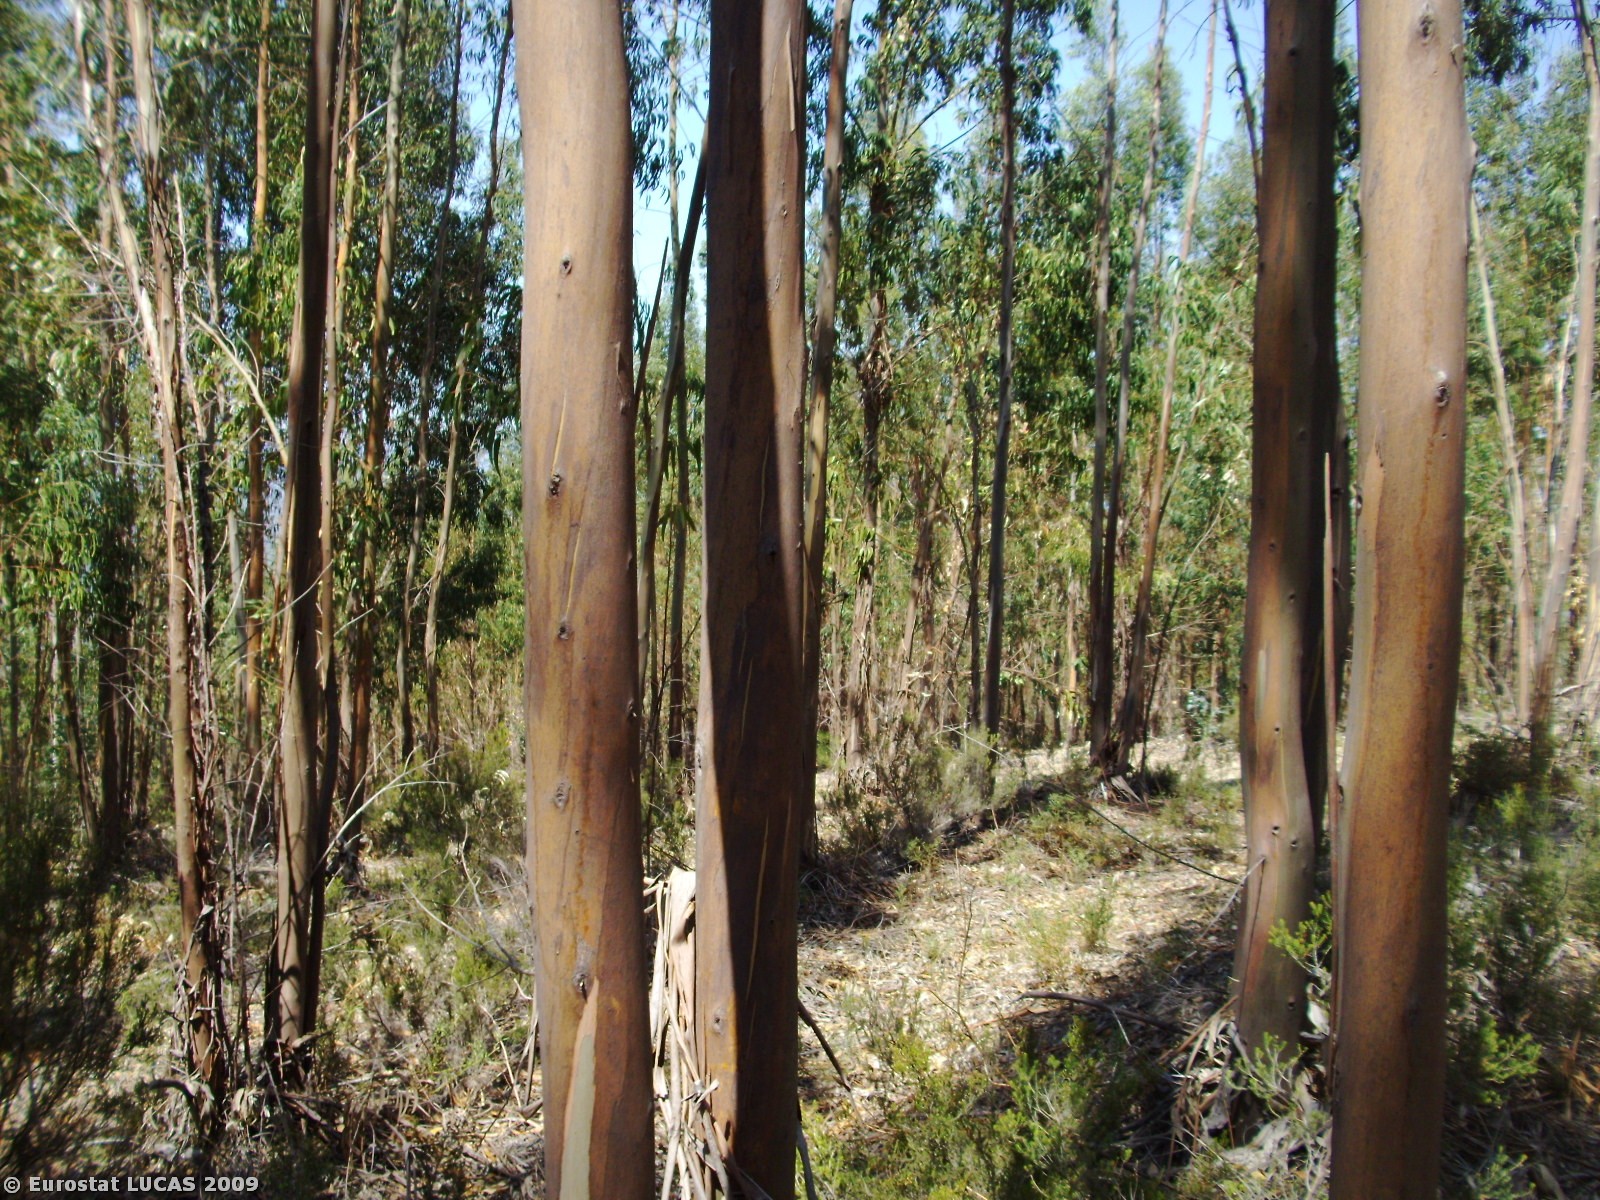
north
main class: Woodland
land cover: Broadleaved woodland
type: plantations and self-sown exotic forest
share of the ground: > 75 %
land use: Forestry
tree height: > 5 m
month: August
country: PT
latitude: 40.1553
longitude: -7.6121
